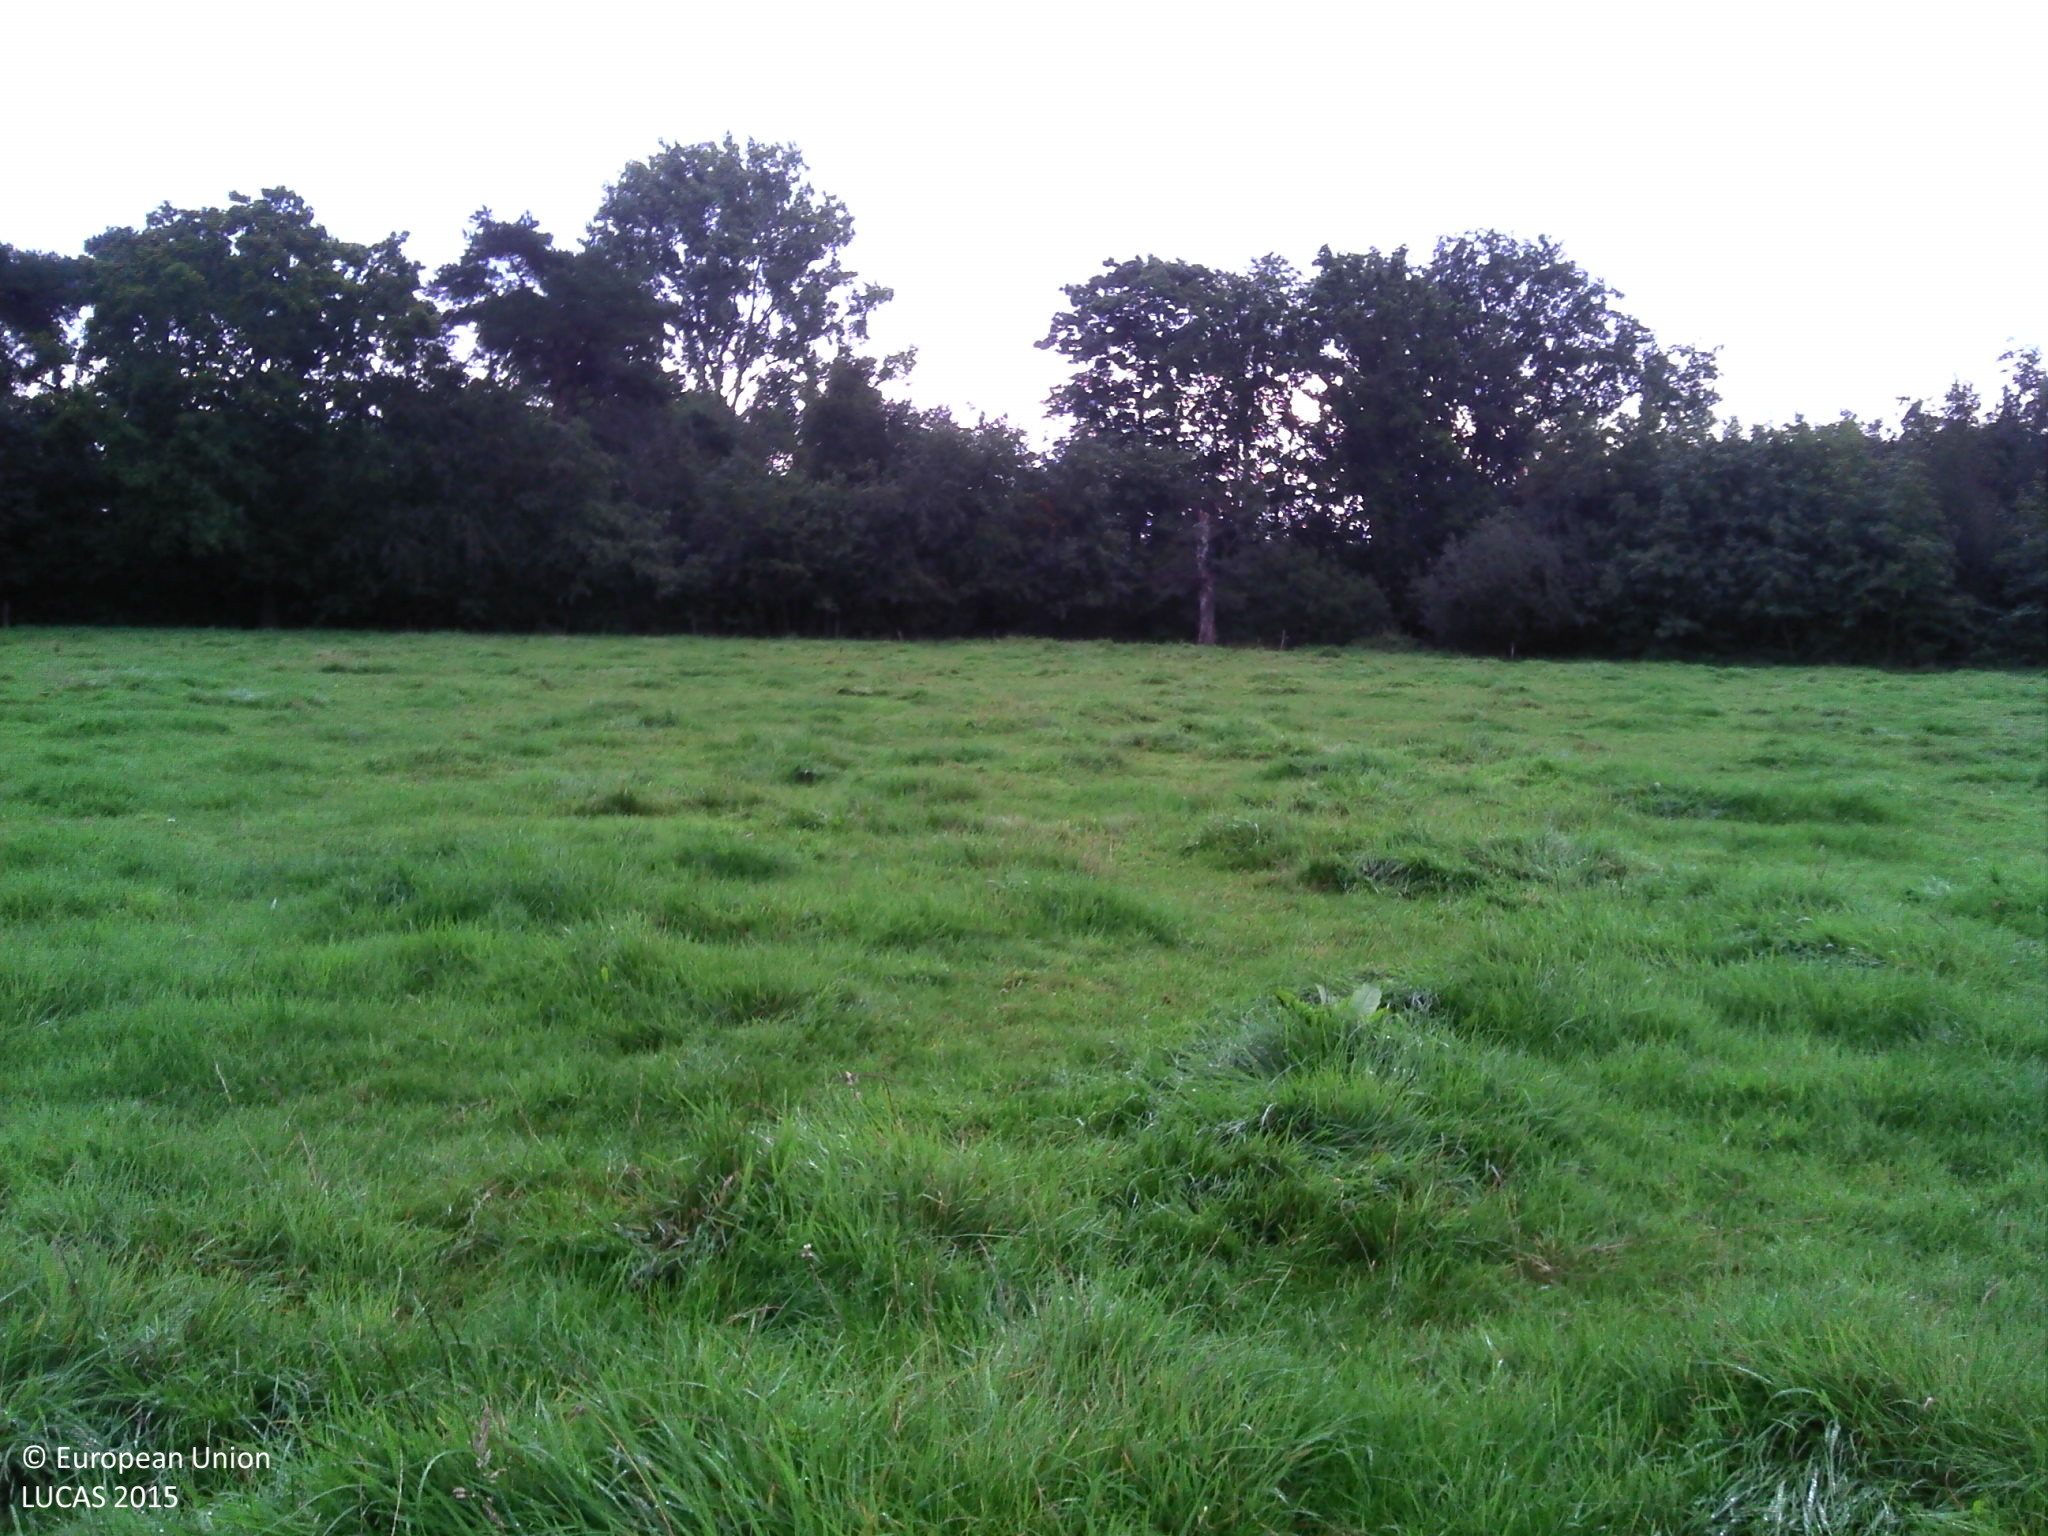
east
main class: Grassland
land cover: Grassland without tree/shrub cover
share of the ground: > 75 %
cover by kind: herbaceous plants 100 %
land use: Agriculture (excluding fallow land and kitchen gardens)
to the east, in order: Grassland without tree/shrub cover; Fences; Broadleaved woodland; Ponds and wetlands; Broadleaved woodland; Grass margins; Paved roads, cycling and walking lanes; Grass margins; Ditches and canals; Grass margins; Nurseries; Sugar beet; Nurseries
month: September
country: BE
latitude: 51.4312
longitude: 4.7175
